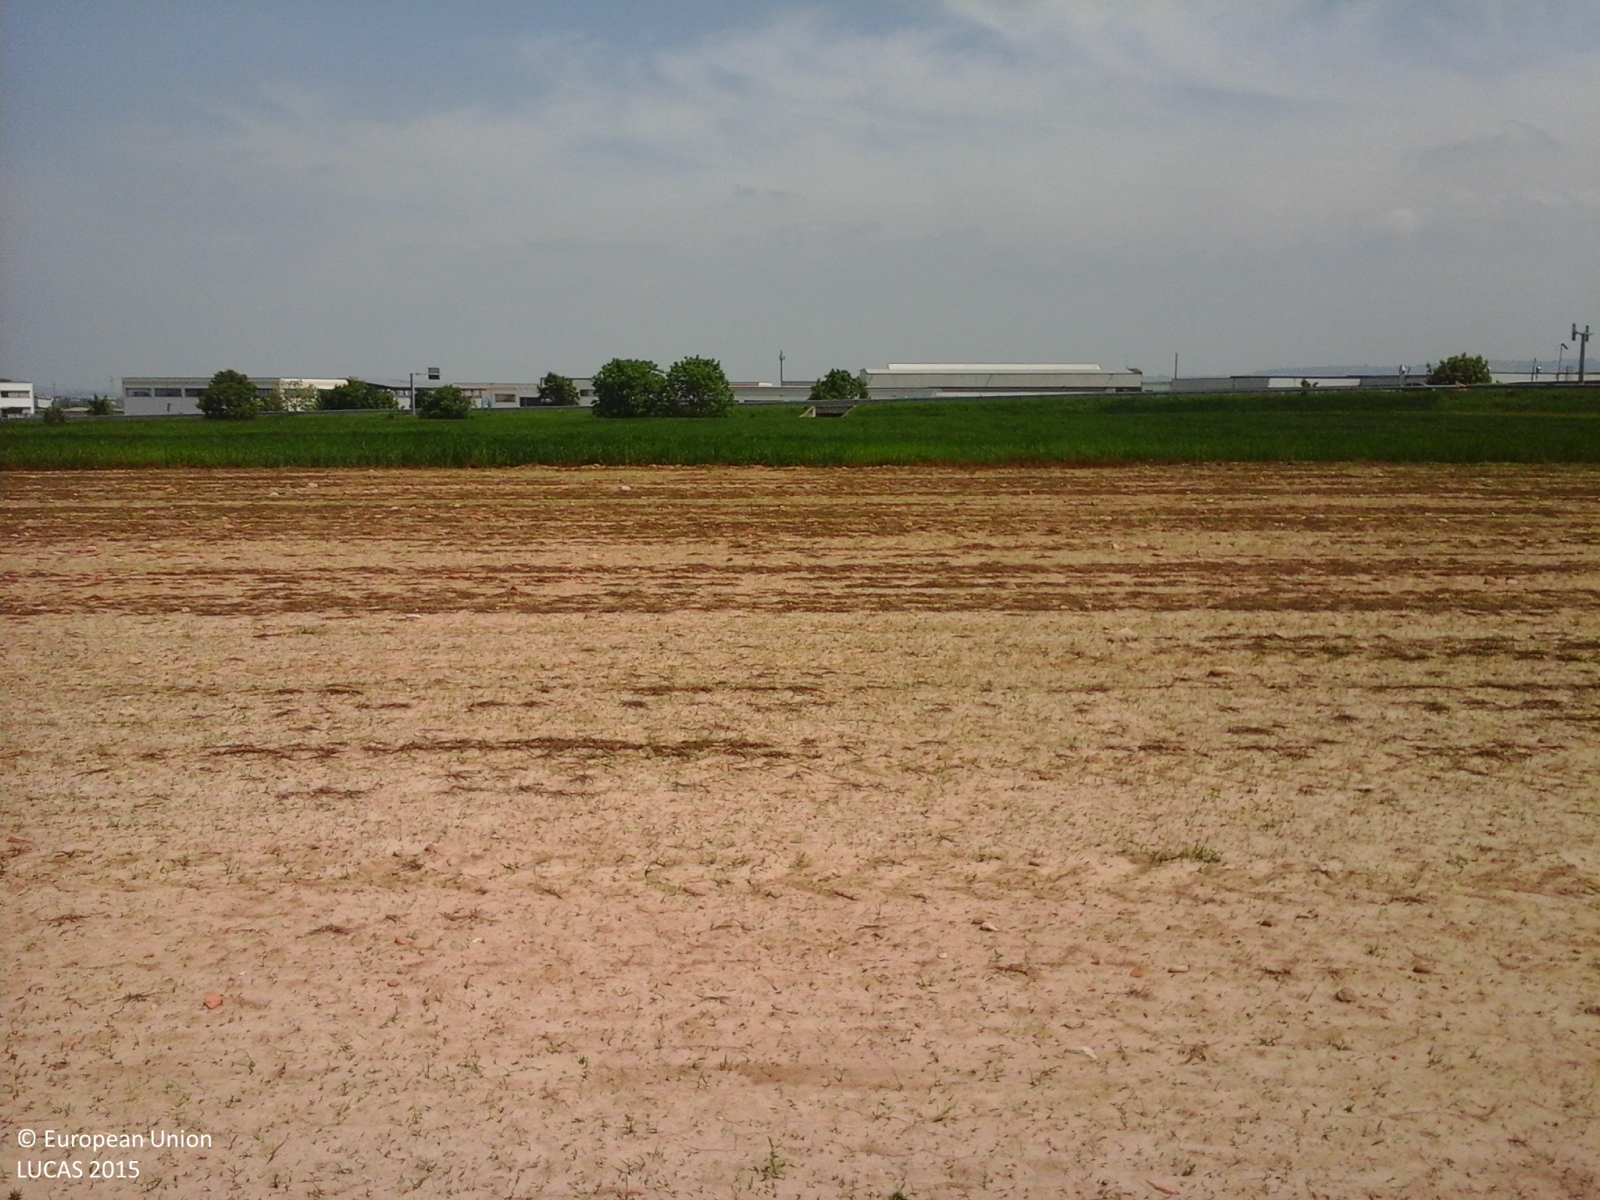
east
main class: Cropland
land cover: Common wheat
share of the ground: > 75 %
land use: Agriculture (excluding fallow land and kitchen gardens)
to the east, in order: Common wheat; Other bare soil; Common wheat; Grassland without tree/shrub cover
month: May
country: IT
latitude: 44.6705
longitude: 7.8221
